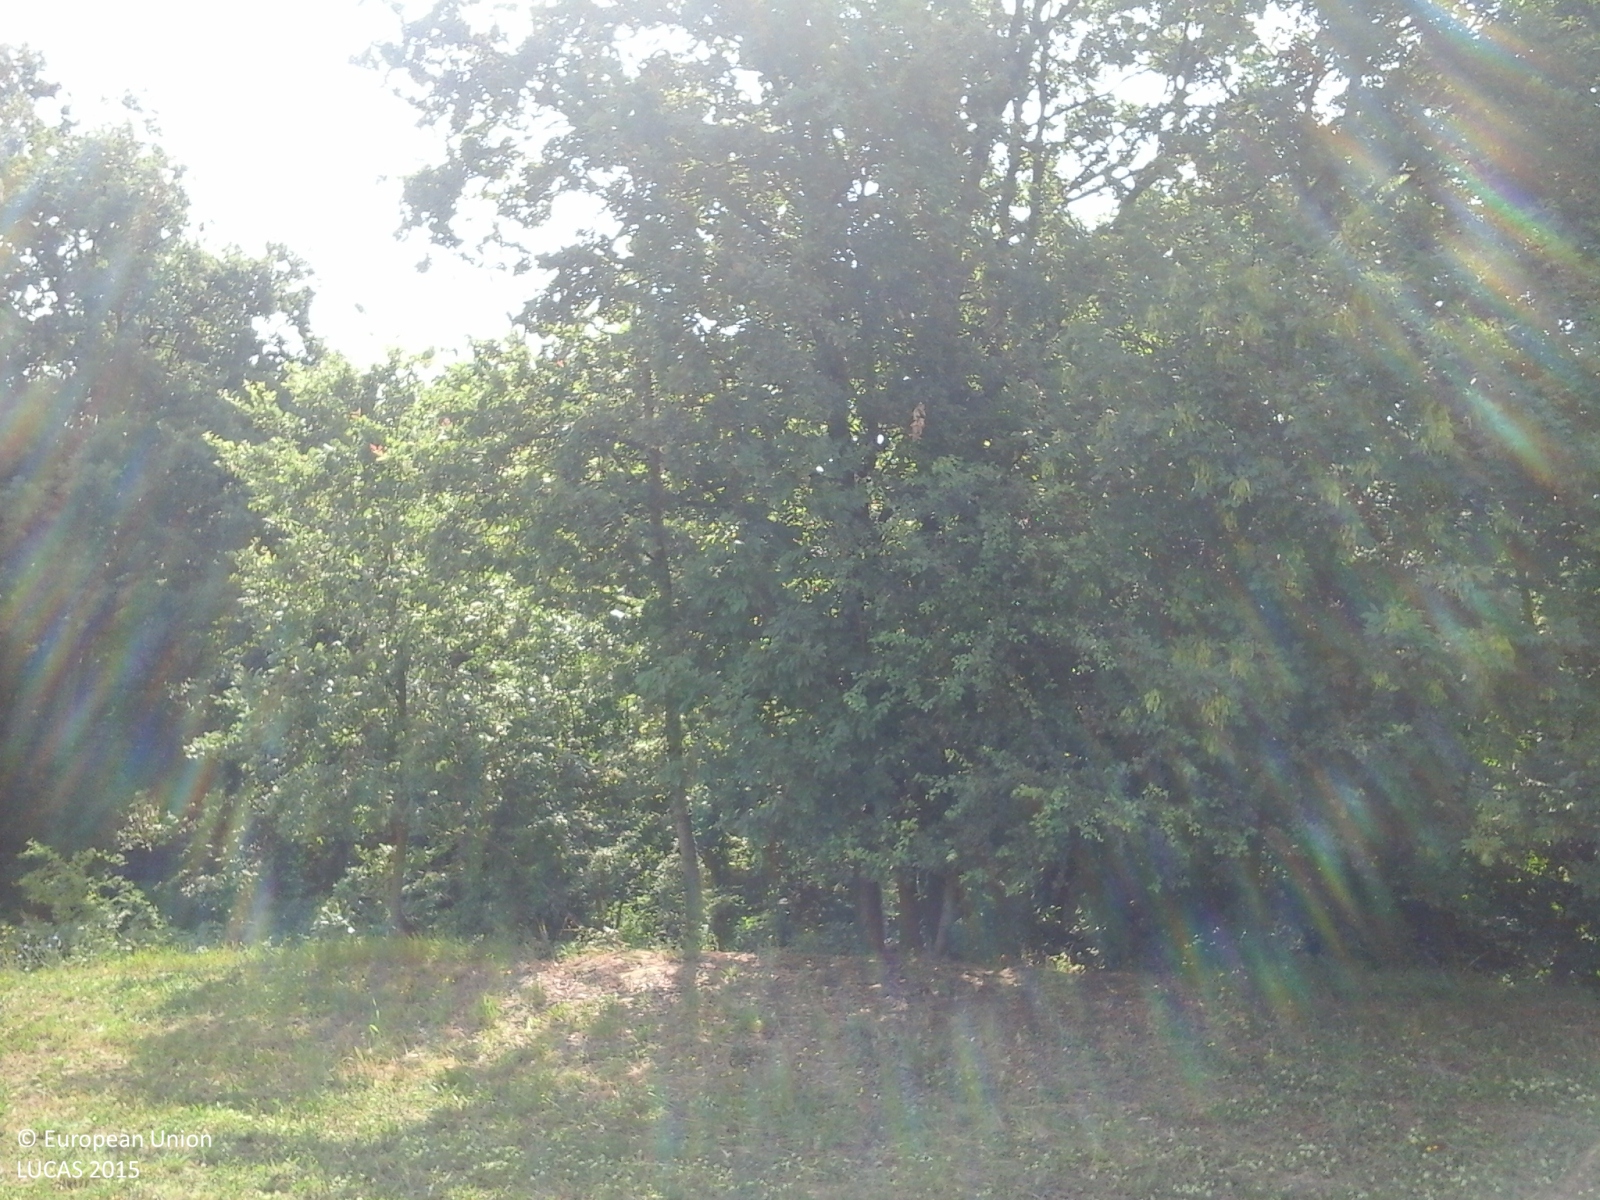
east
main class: Grassland
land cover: Grassland without tree/shrub cover
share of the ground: > 75 %
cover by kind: herbaceous plants 100 %
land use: Agriculture (excluding fallow land and kitchen gardens)
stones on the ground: 10 - 25 %
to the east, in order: Grassland without tree/shrub cover; Broadleaved woodland; Ditches and canals; Broadleaved woodland
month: June
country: IT
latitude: 44.7291
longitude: 10.1890
